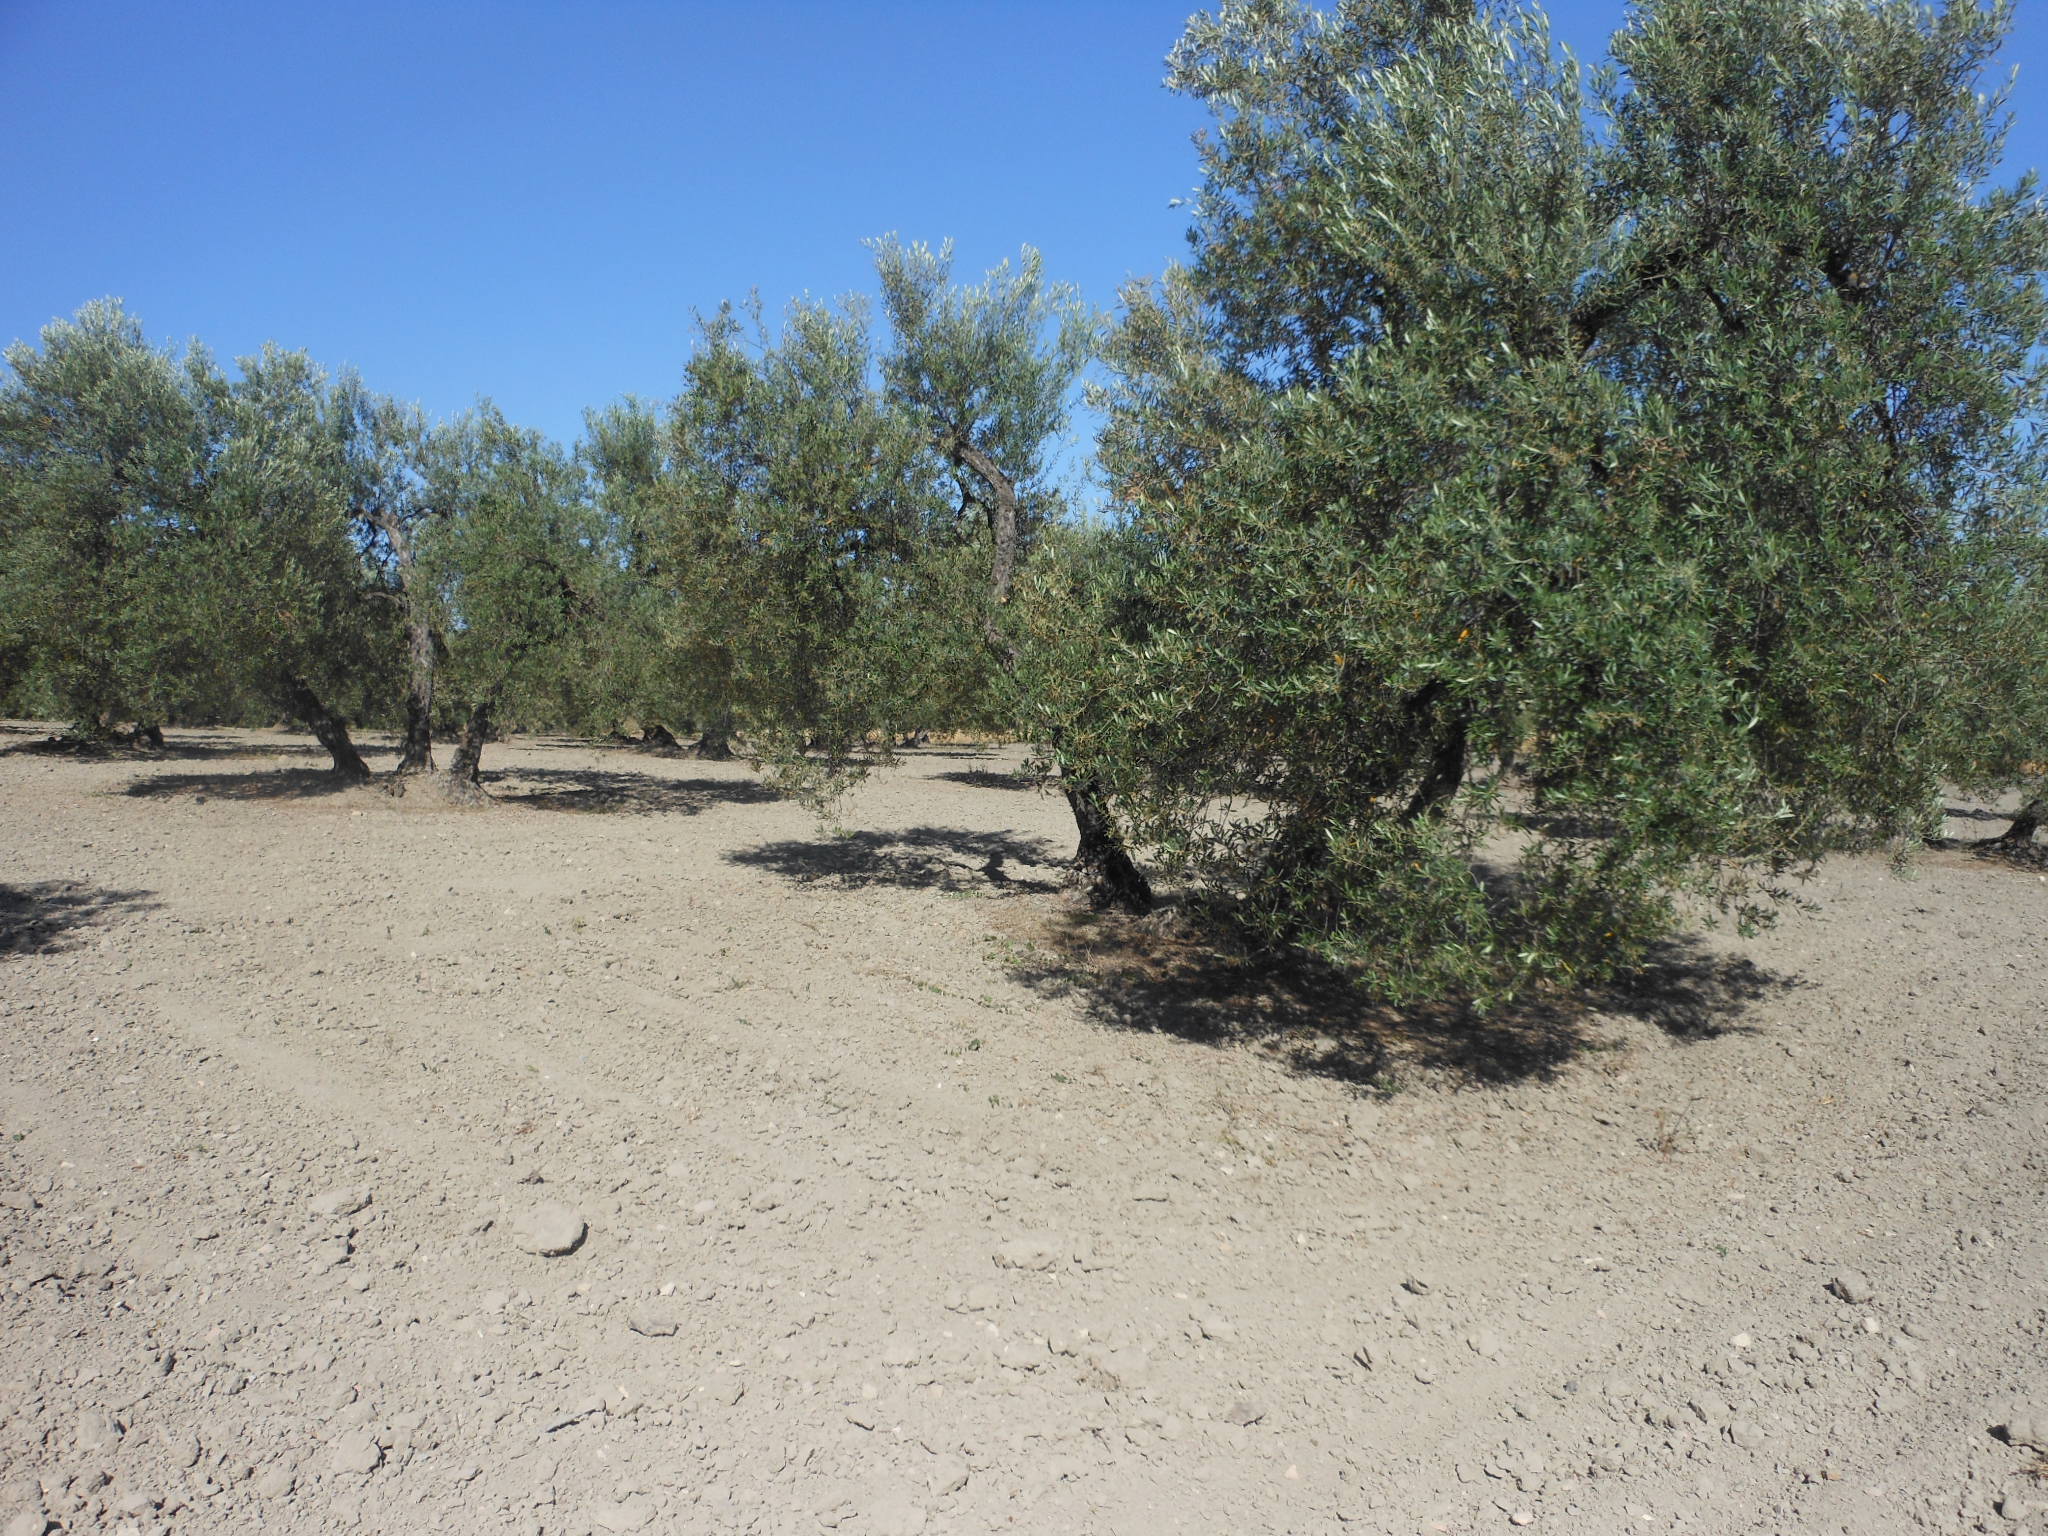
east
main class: Cropland
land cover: Olive groves
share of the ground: 25 - 50 %
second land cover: Other bare soil
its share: > 75 %
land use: Agriculture (excluding fallow land and kitchen gardens)
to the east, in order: Olive groves; Other bare soil; Grass margins; Common wheat; Grass margins; Durum wheat
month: May
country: ES
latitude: 37.2680
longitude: -5.5653
